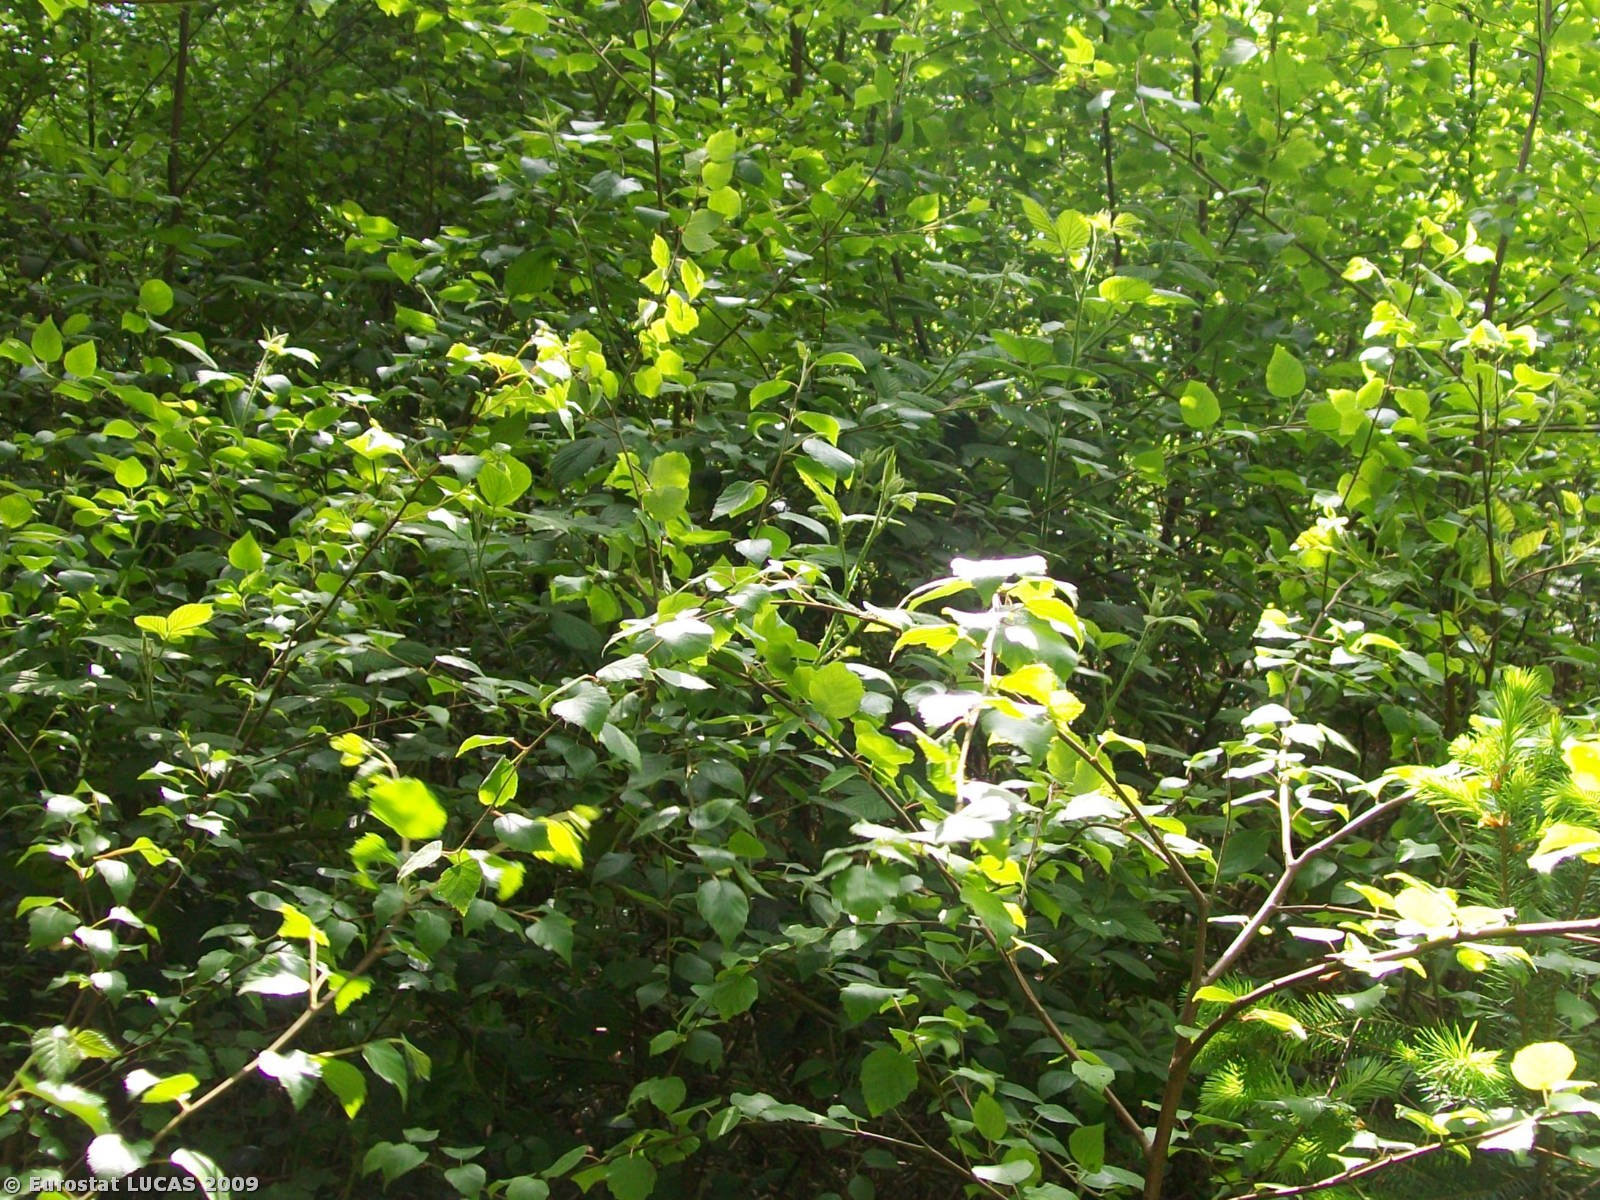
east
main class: Woodland
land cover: Coniferous woodland
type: plantations and self-sown exotic forest
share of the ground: 50 - 75 %
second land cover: Spontaneously vegetated surfaces
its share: > 75 %
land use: Community services
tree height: > 5 m
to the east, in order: Coniferous woodland; Mixed woodland; Tracks; Broadleaved woodland; Coniferous woodland; Tracks; Coniferous woodland
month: May
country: GB
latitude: 51.1837
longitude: -2.1787
